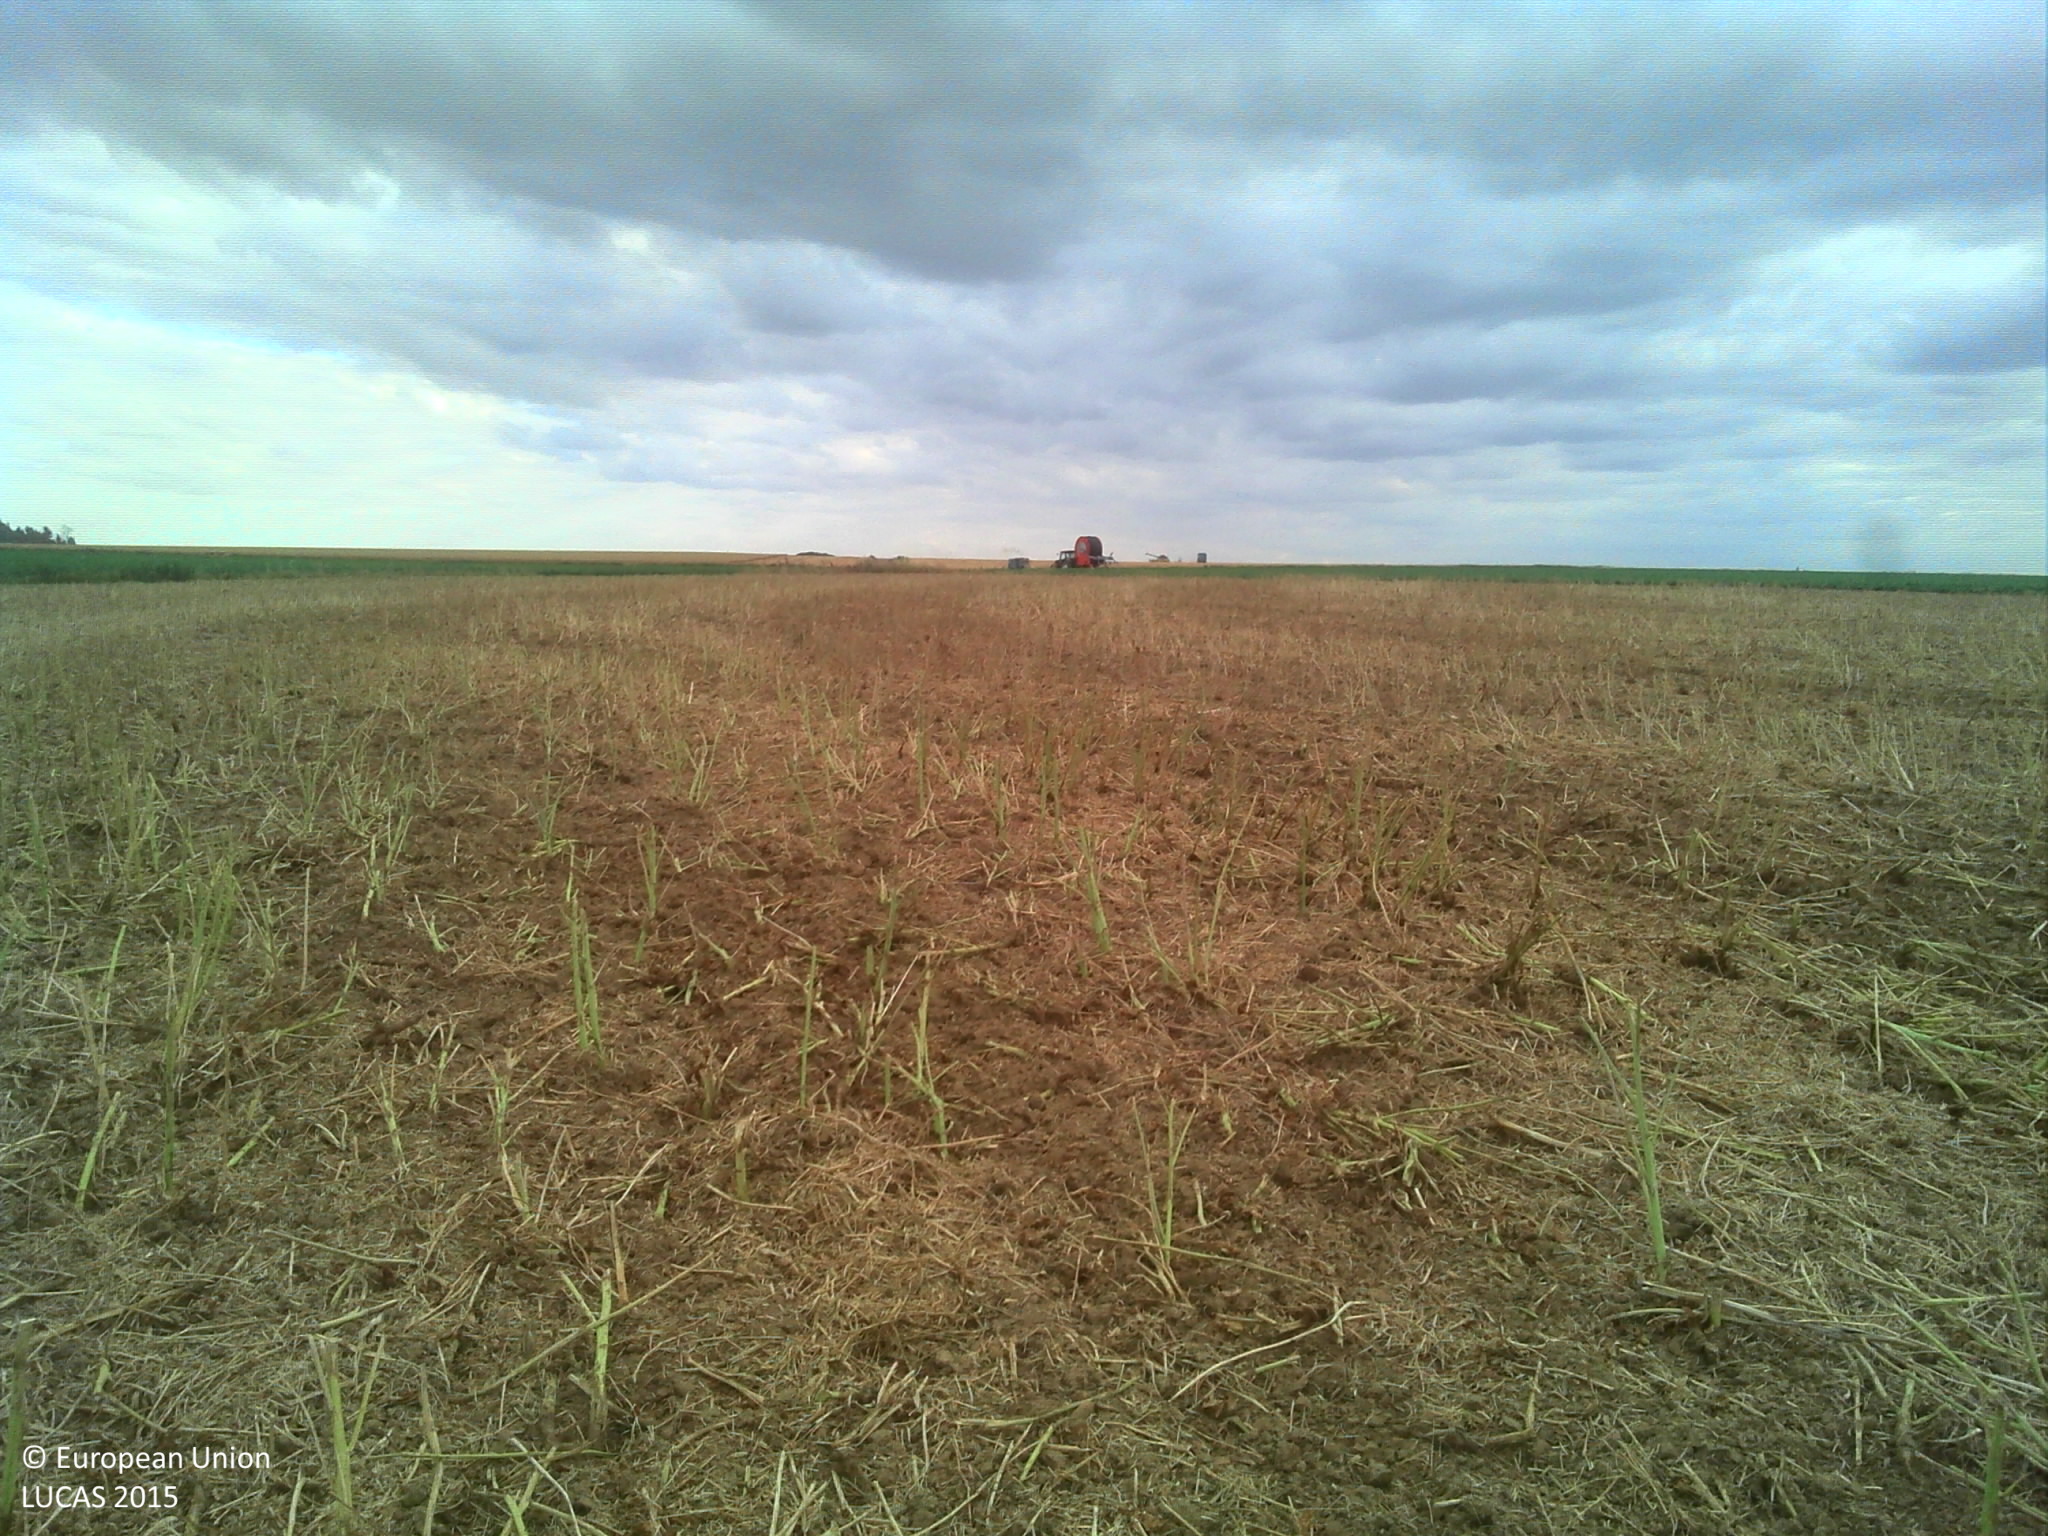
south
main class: Cropland
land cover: Rape and turnip rape
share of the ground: > 75 %
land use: Agriculture (excluding fallow land and kitchen gardens)
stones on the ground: < 10 %
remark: Harvested field
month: July
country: FR
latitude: 48.4350
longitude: 1.2363
